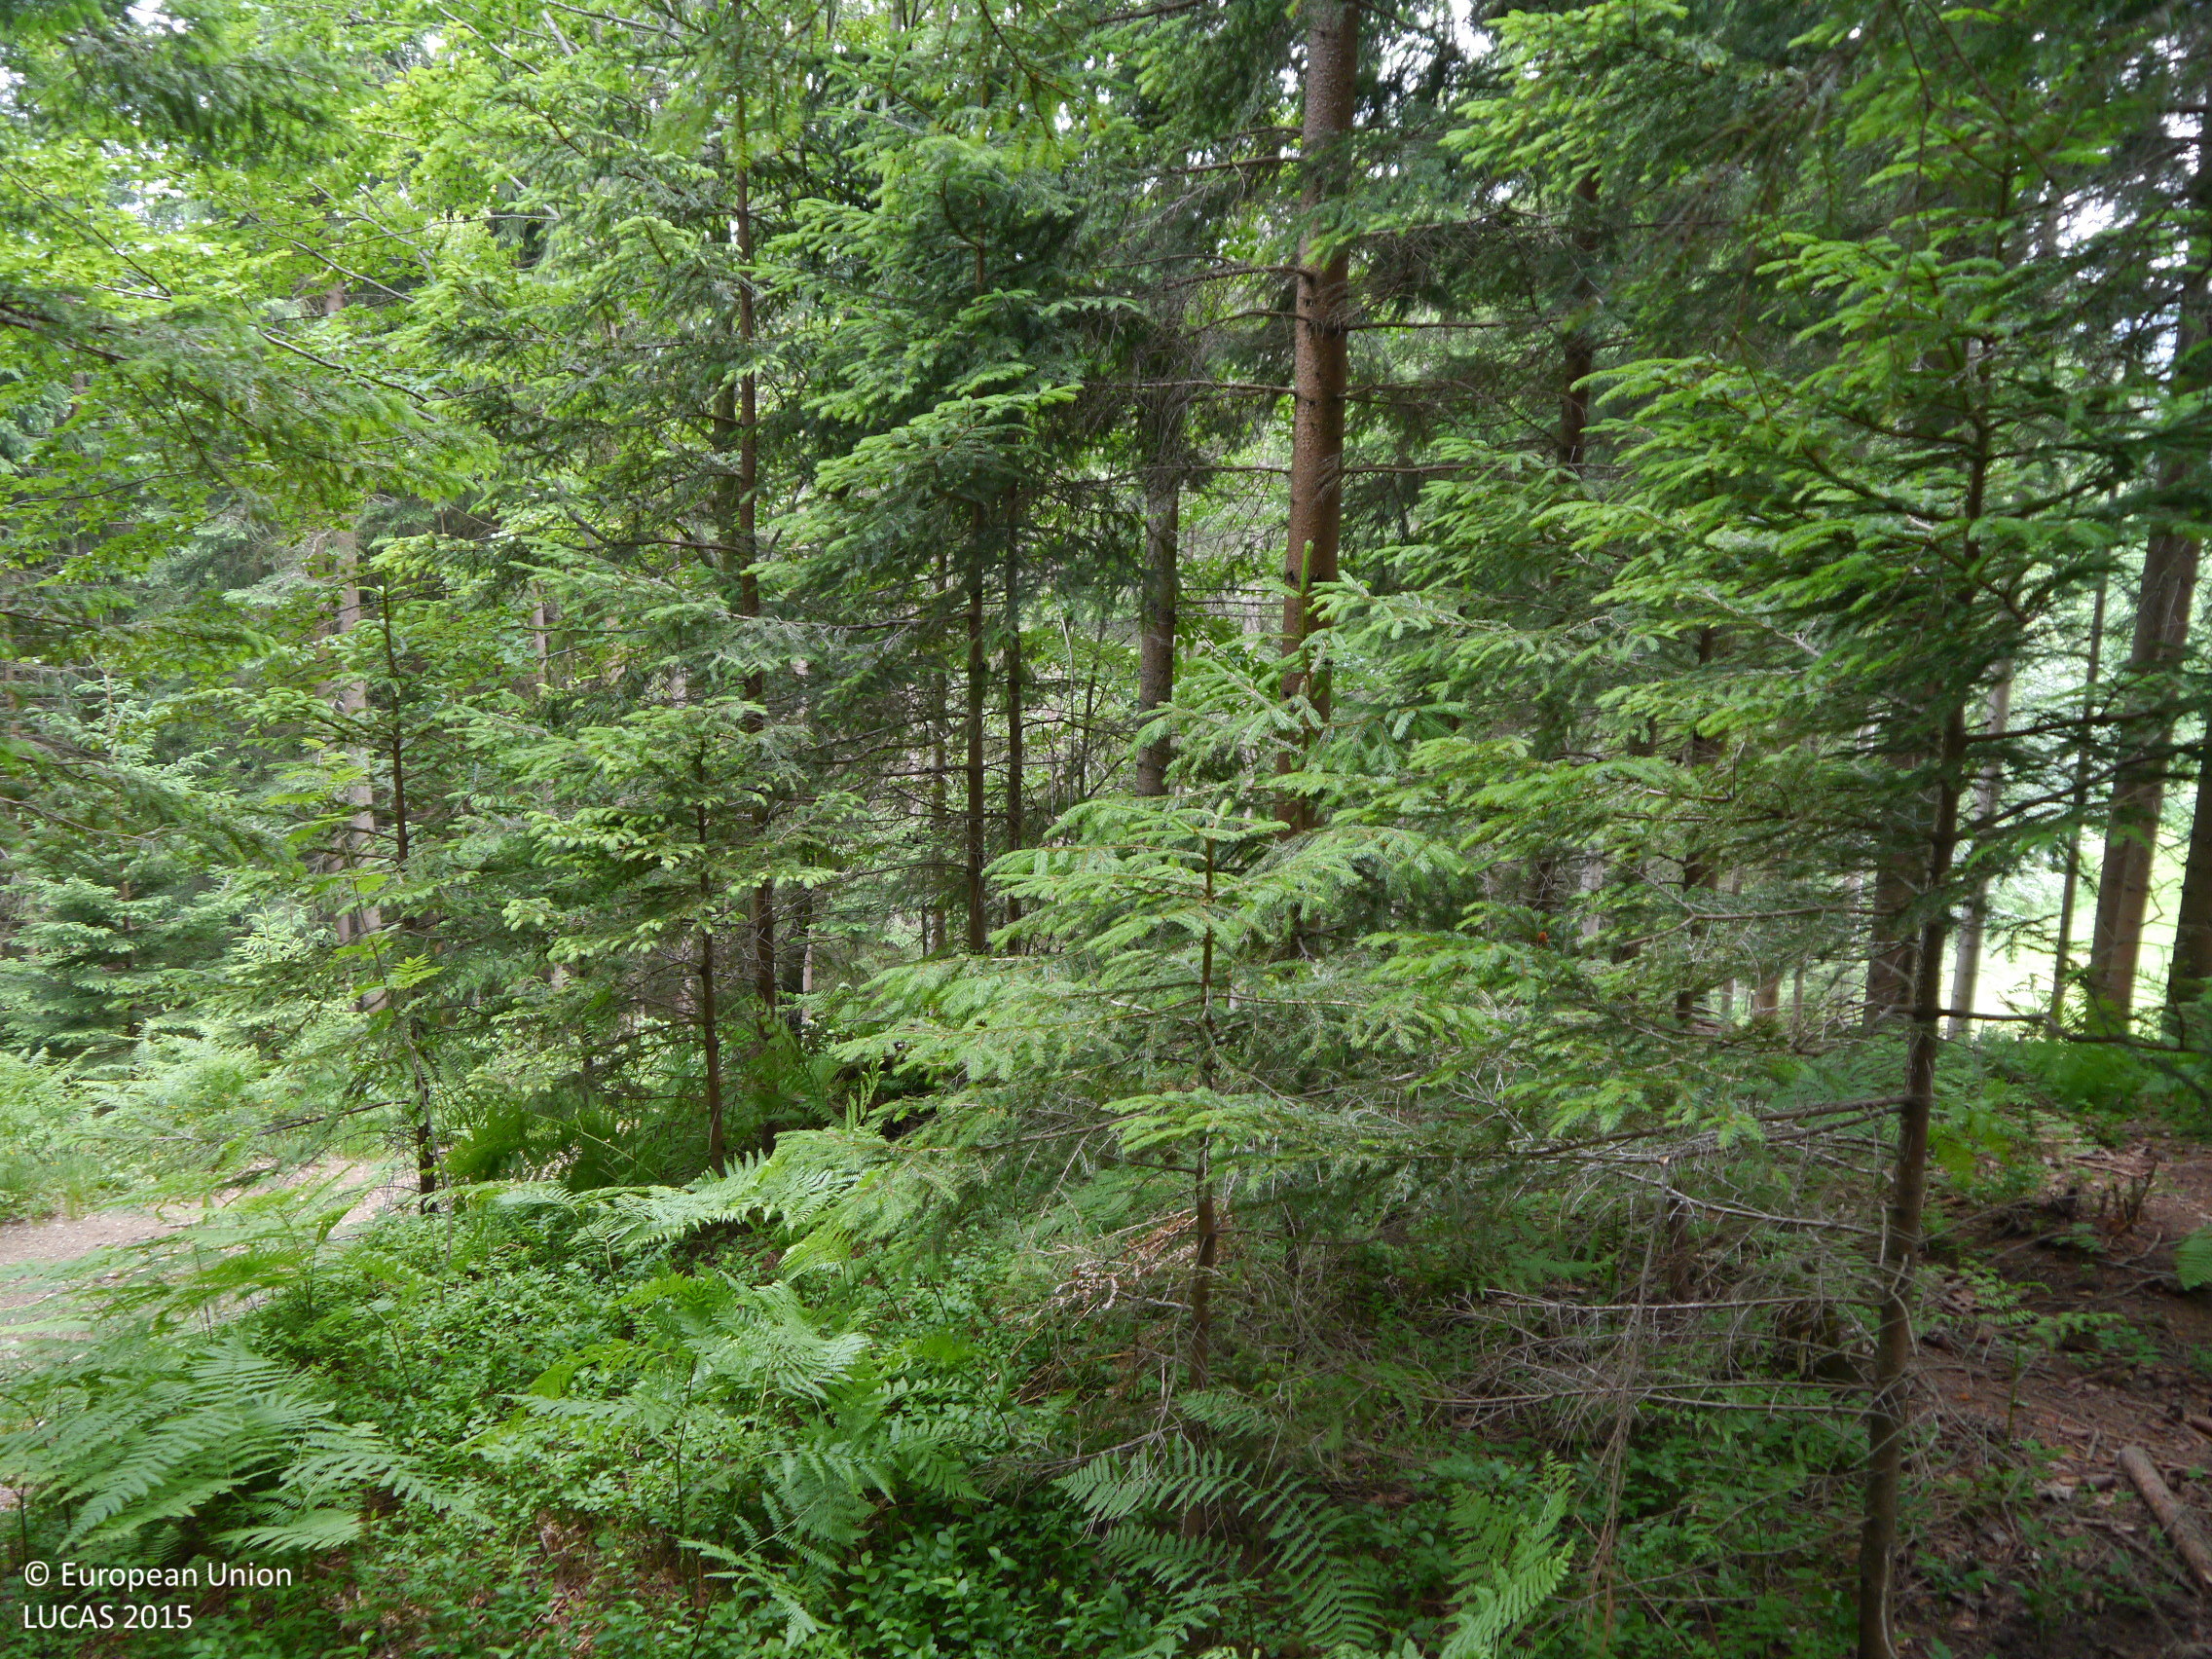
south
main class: Woodland
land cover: Spruce dominated coniferous woodland
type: alpine coniferous forest
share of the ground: > 75 %
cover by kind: coniferous forest trees 100 %
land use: Forestry
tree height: > 5 m
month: June
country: AT
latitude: 46.6814
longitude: 15.0841
